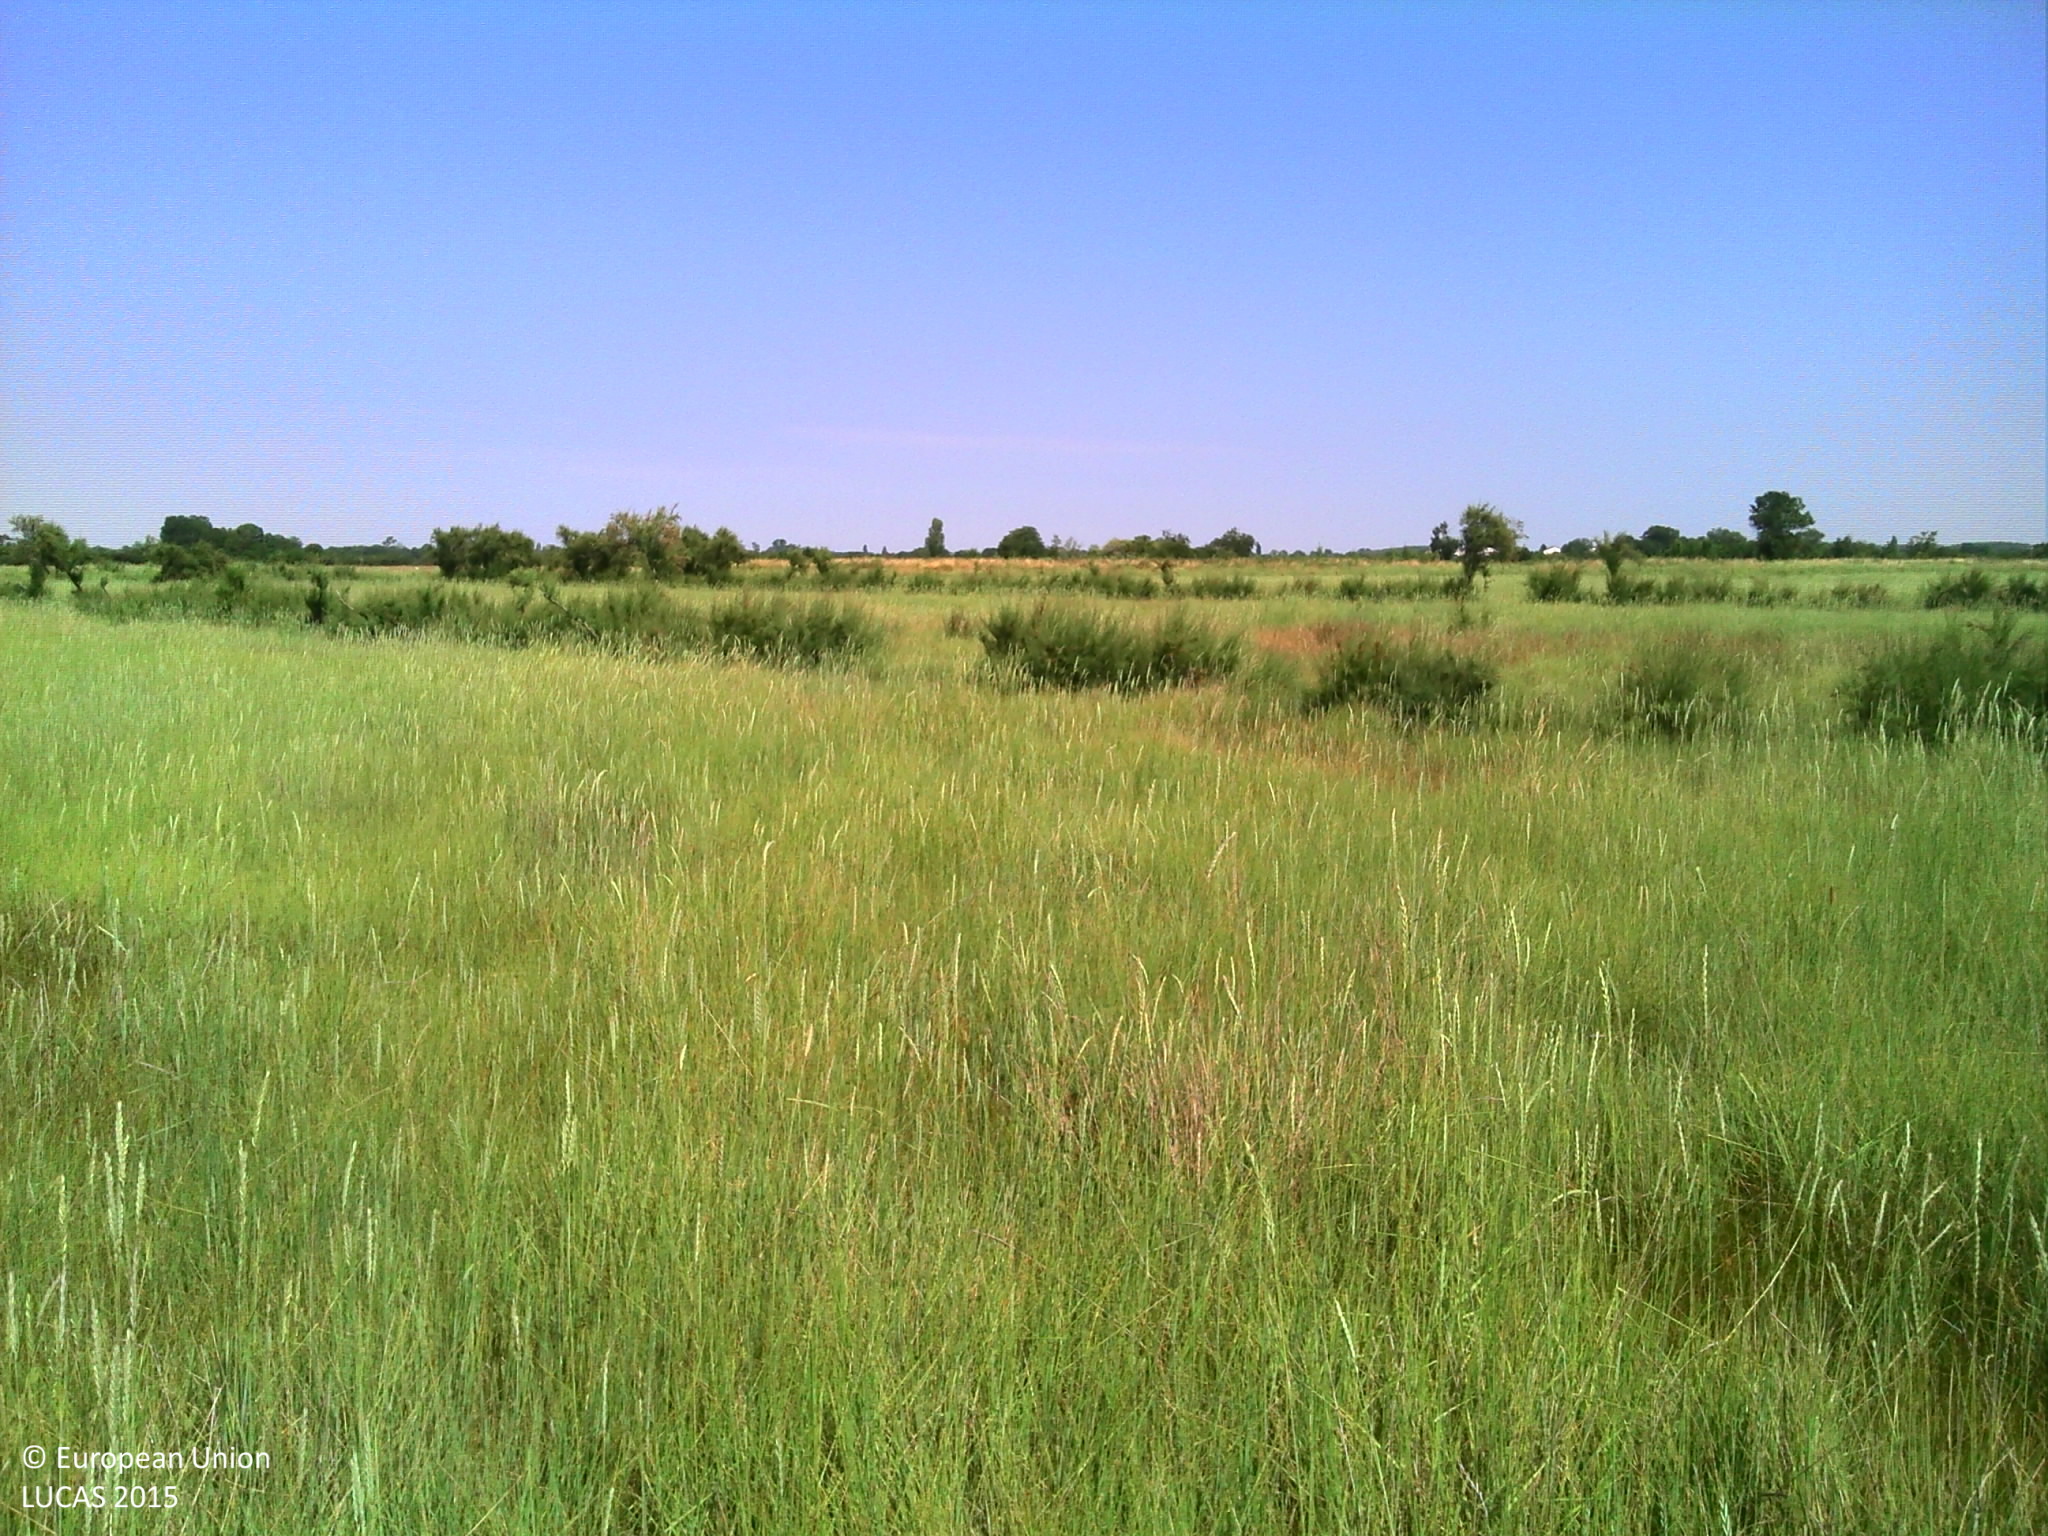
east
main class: Grassland
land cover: Grassland without tree/shrub cover
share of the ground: > 75 %
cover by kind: herbaceous plants 100 %
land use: Agriculture (excluding fallow land and kitchen gardens)
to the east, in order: Grassland without tree/shrub cover; Abandoned hedges; Grassland without tree/shrub cover; Abandoned hedges; Grassland without tree/shrub cover; Ditches and canals; Grassland without tree/shrub cover; Rivers and streams; Grassland without tree/shrub cover; Other bare soil; Inland marshes; Grassland without tree/shrub cover
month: June
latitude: 45.6958
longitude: -0.9560
